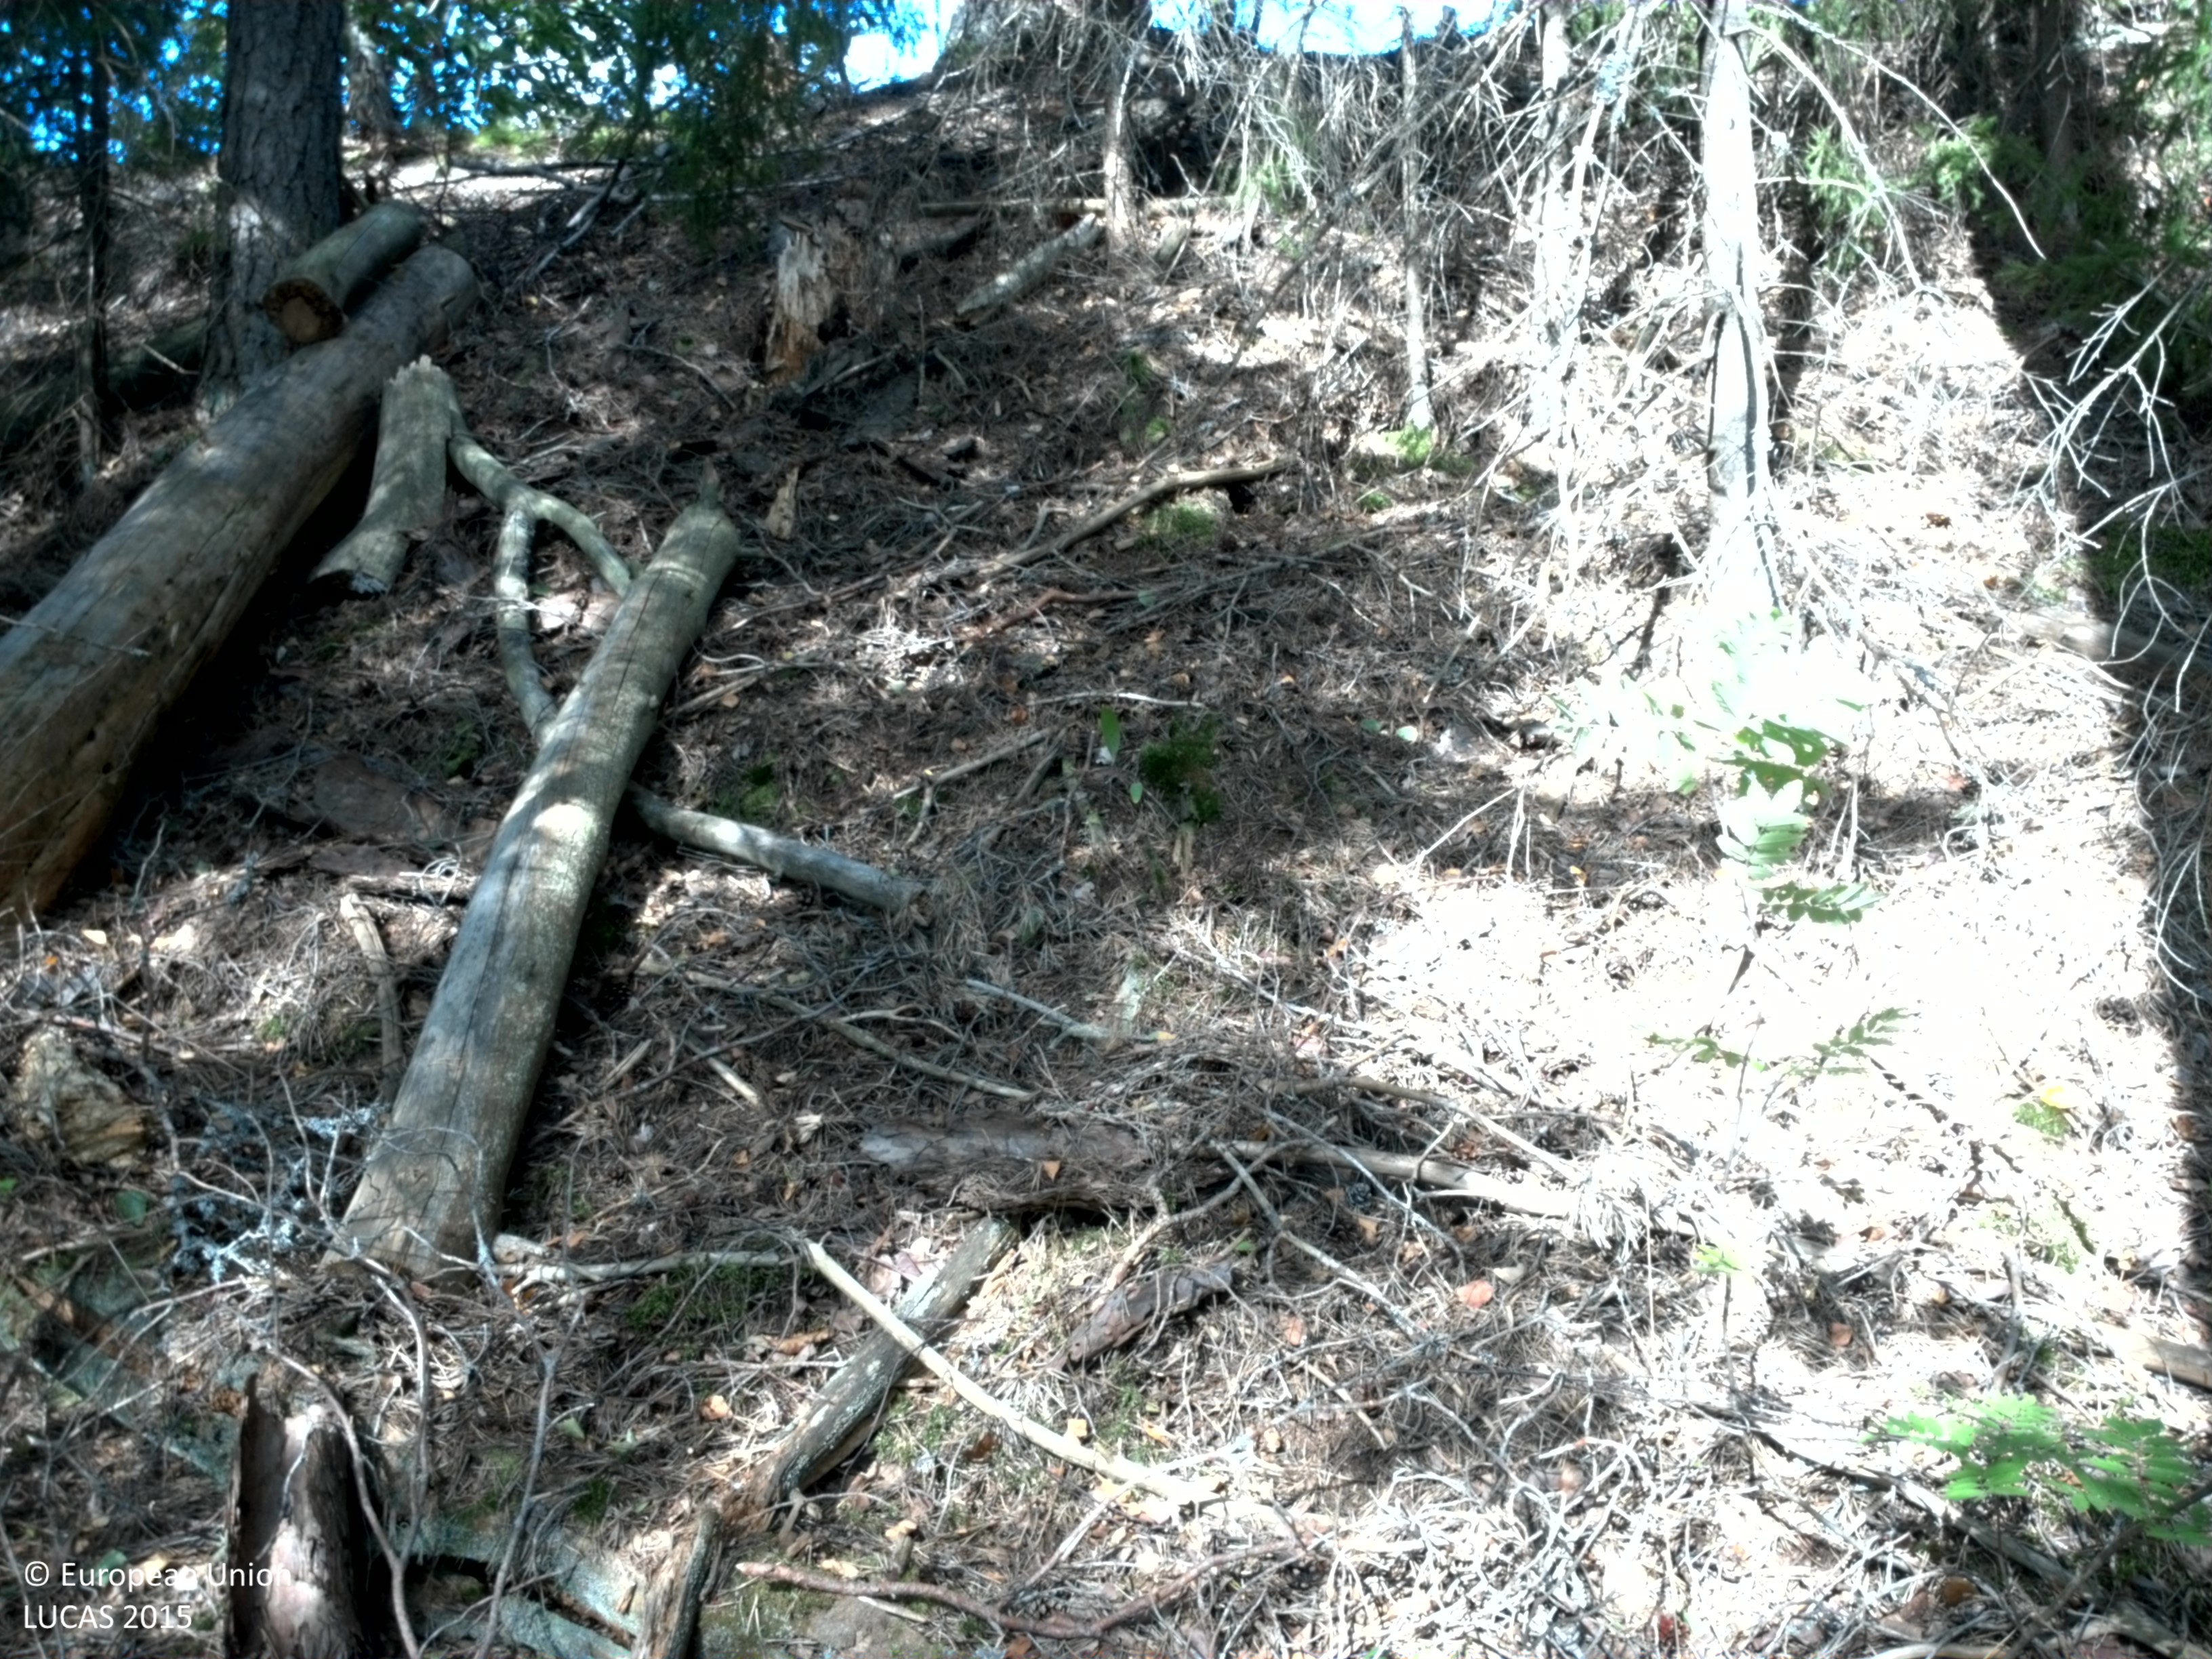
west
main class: Woodland
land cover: Pine dominated coniferous woodland
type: boreal forest
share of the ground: 50 - 75 %
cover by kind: coniferous forest trees 60 %, lichens and mosses 20 %, consolidated bare surface 10 %, broadleaved forest trees 5 %, herbaceous plants 5 %
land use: Amenities, museums, leisure
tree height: > 5 m
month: August
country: SE
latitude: 59.5082
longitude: 13.4373
